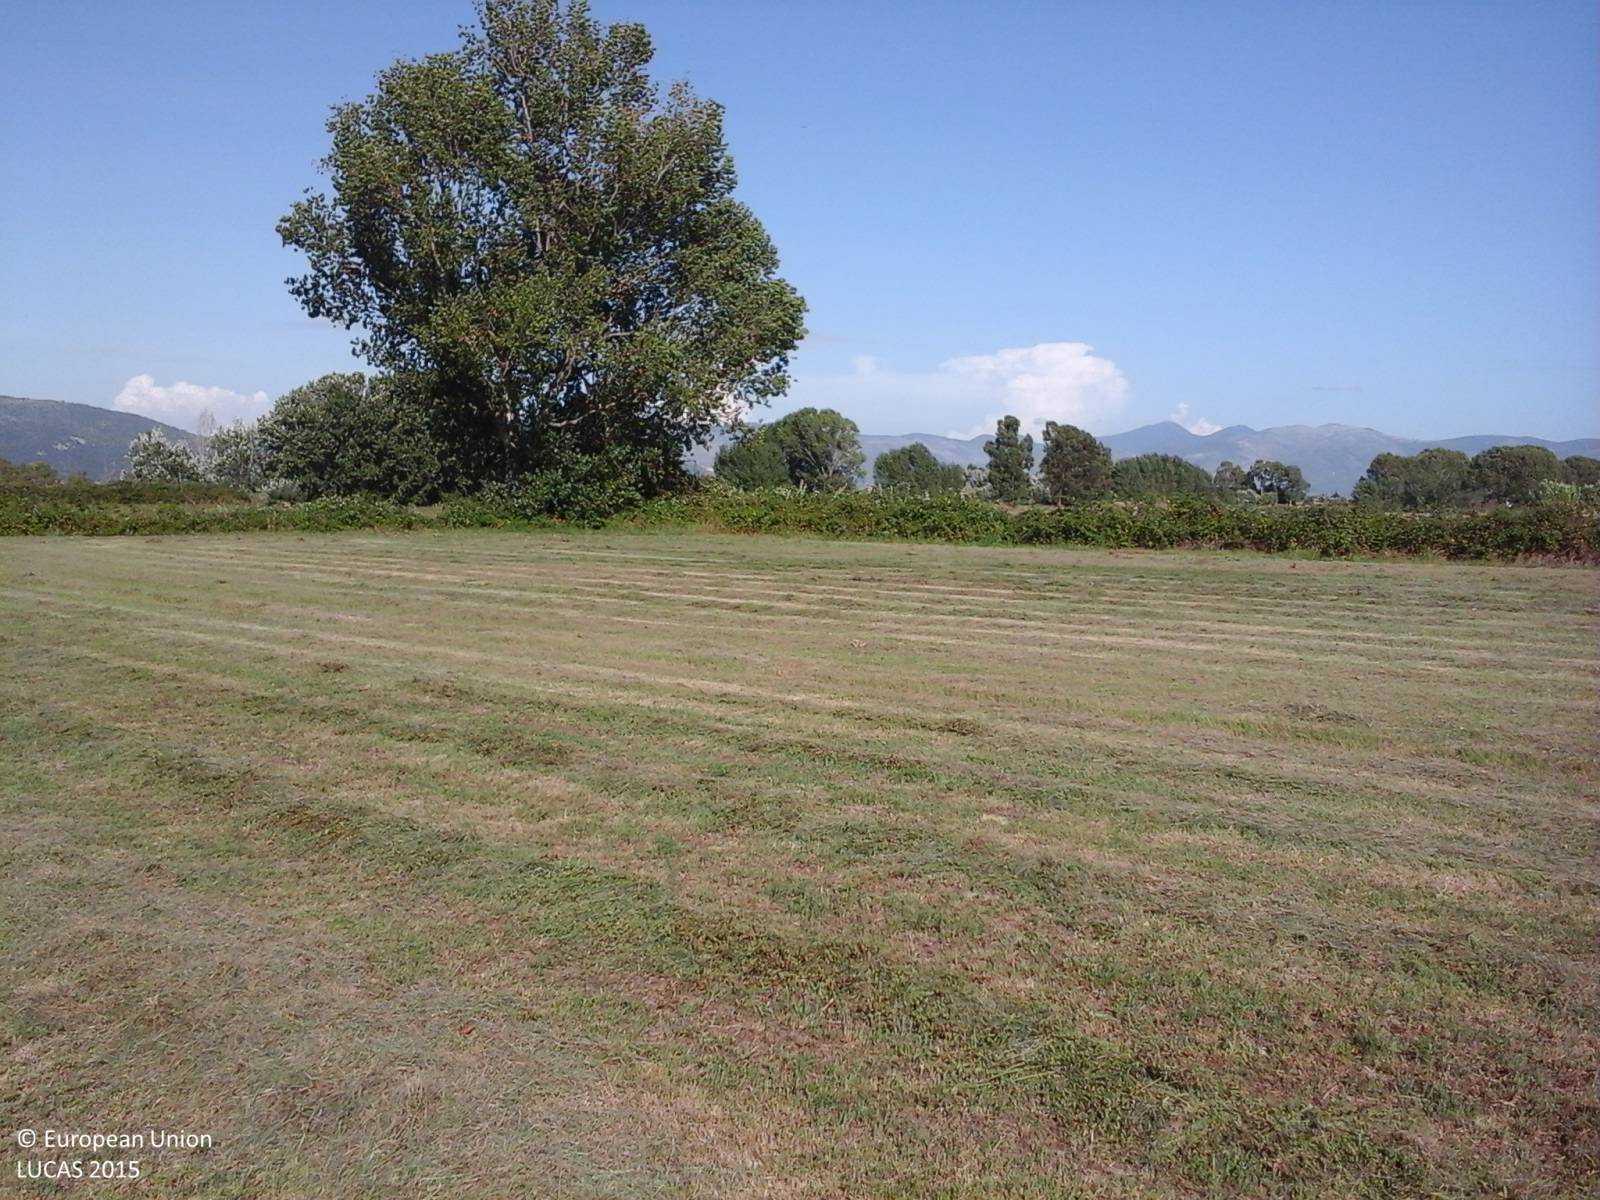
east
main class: Cropland
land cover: Temporary grasslands
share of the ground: > 75 %
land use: Agriculture (excluding fallow land and kitchen gardens)
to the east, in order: Temporary grasslands; Shruby margins; Ditches and canals; Shruby margins; Lucerne; Ditches and canals; Lucerne; Ditches and canals; Maize
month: August
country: IT
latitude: 41.4324
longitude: 13.0633
